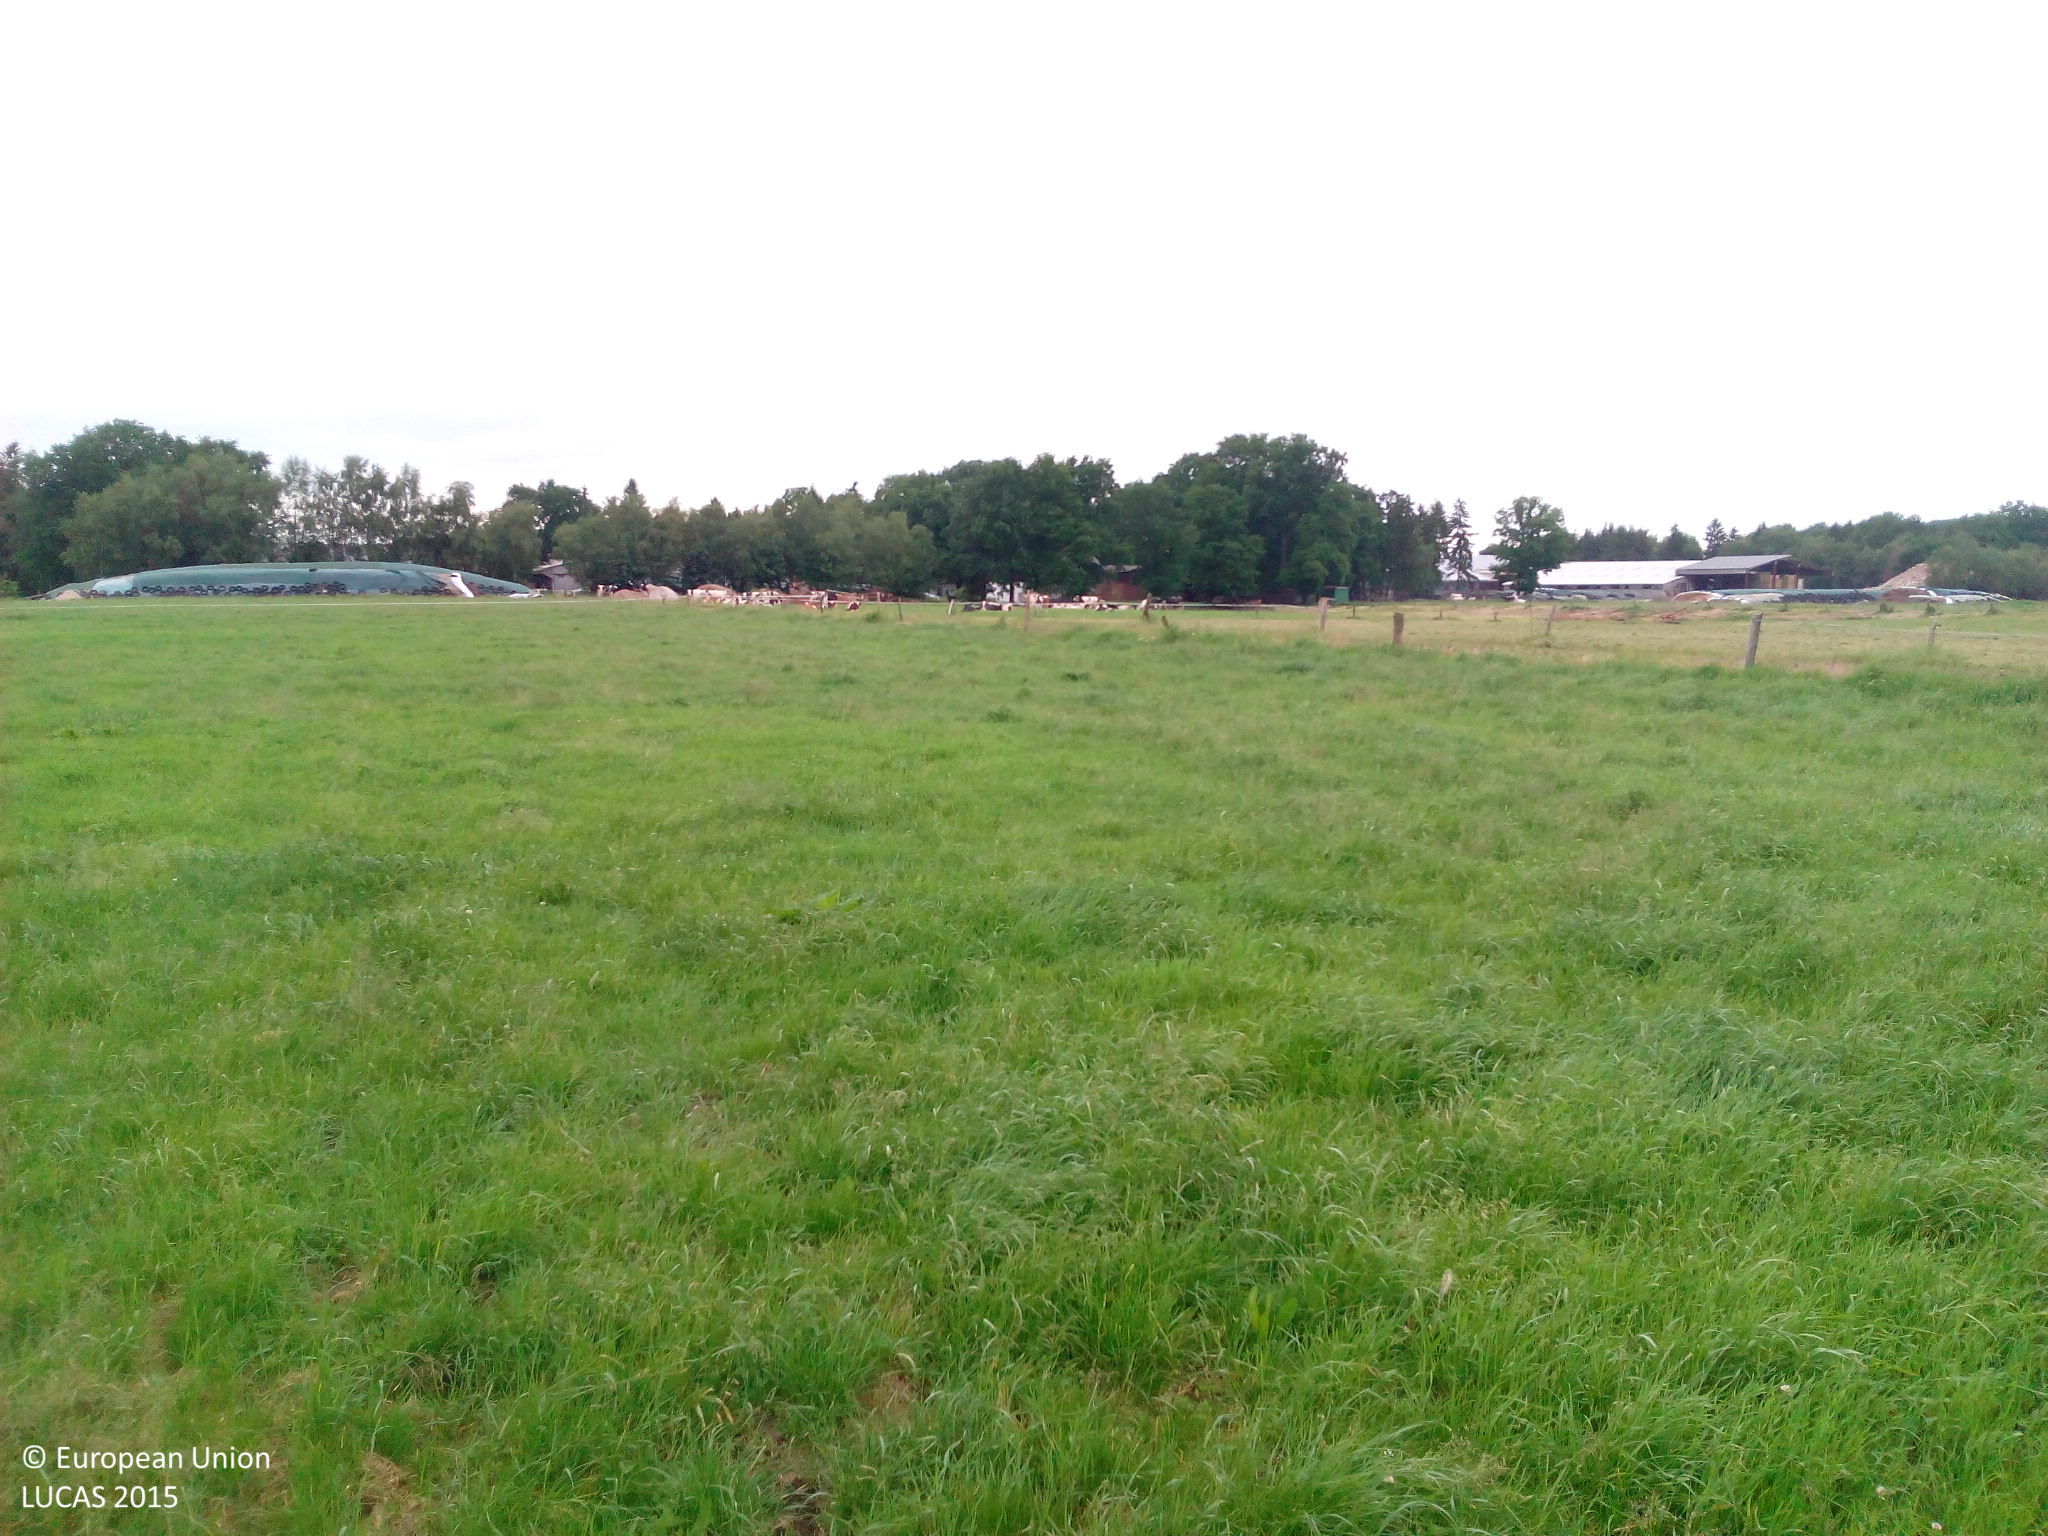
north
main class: Grassland
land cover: Grassland without tree/shrub cover
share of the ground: > 75 %
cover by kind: herbaceous plants 100 %
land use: Agriculture (excluding fallow land and kitchen gardens)
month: June
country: DE
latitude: 53.4344
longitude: 9.0822
